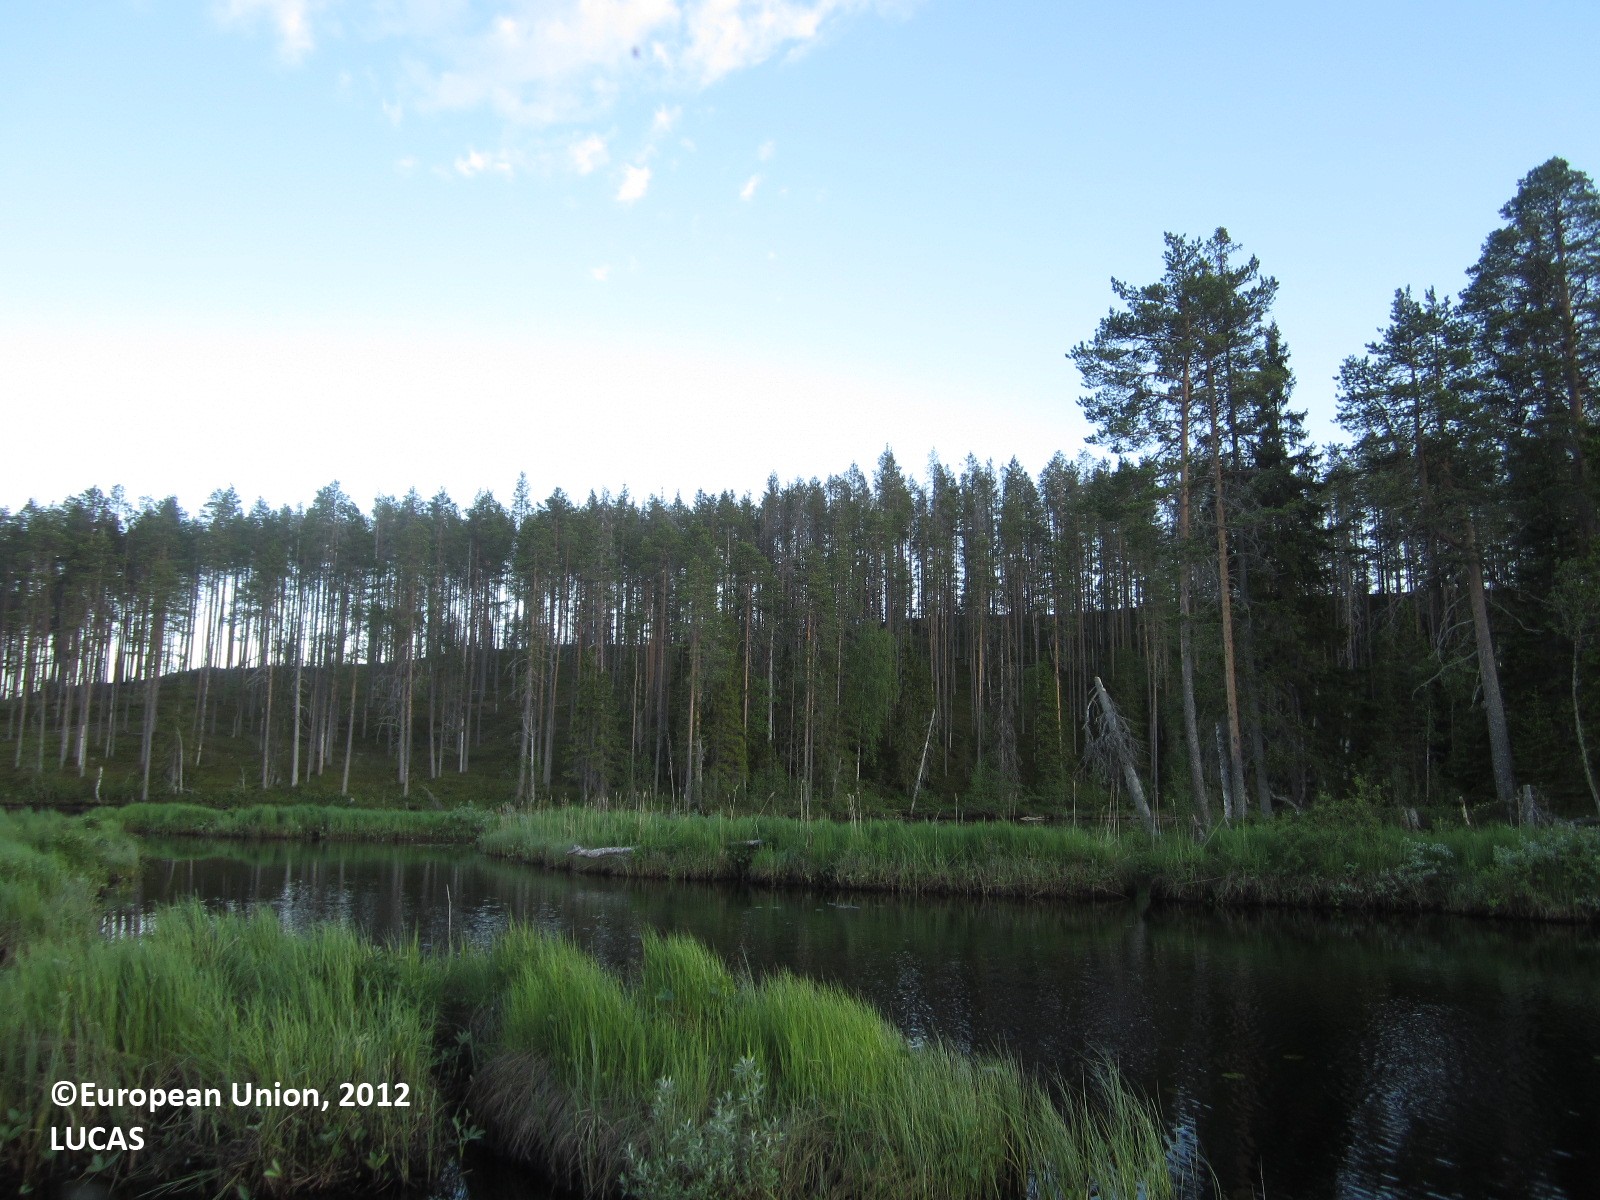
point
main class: Woodland
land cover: Pine dominated coniferous woodland
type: boreal forest
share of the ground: > 75 %
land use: Forestry
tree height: > 5 m
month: June
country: FI
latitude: 64.8277
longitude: 29.2689
